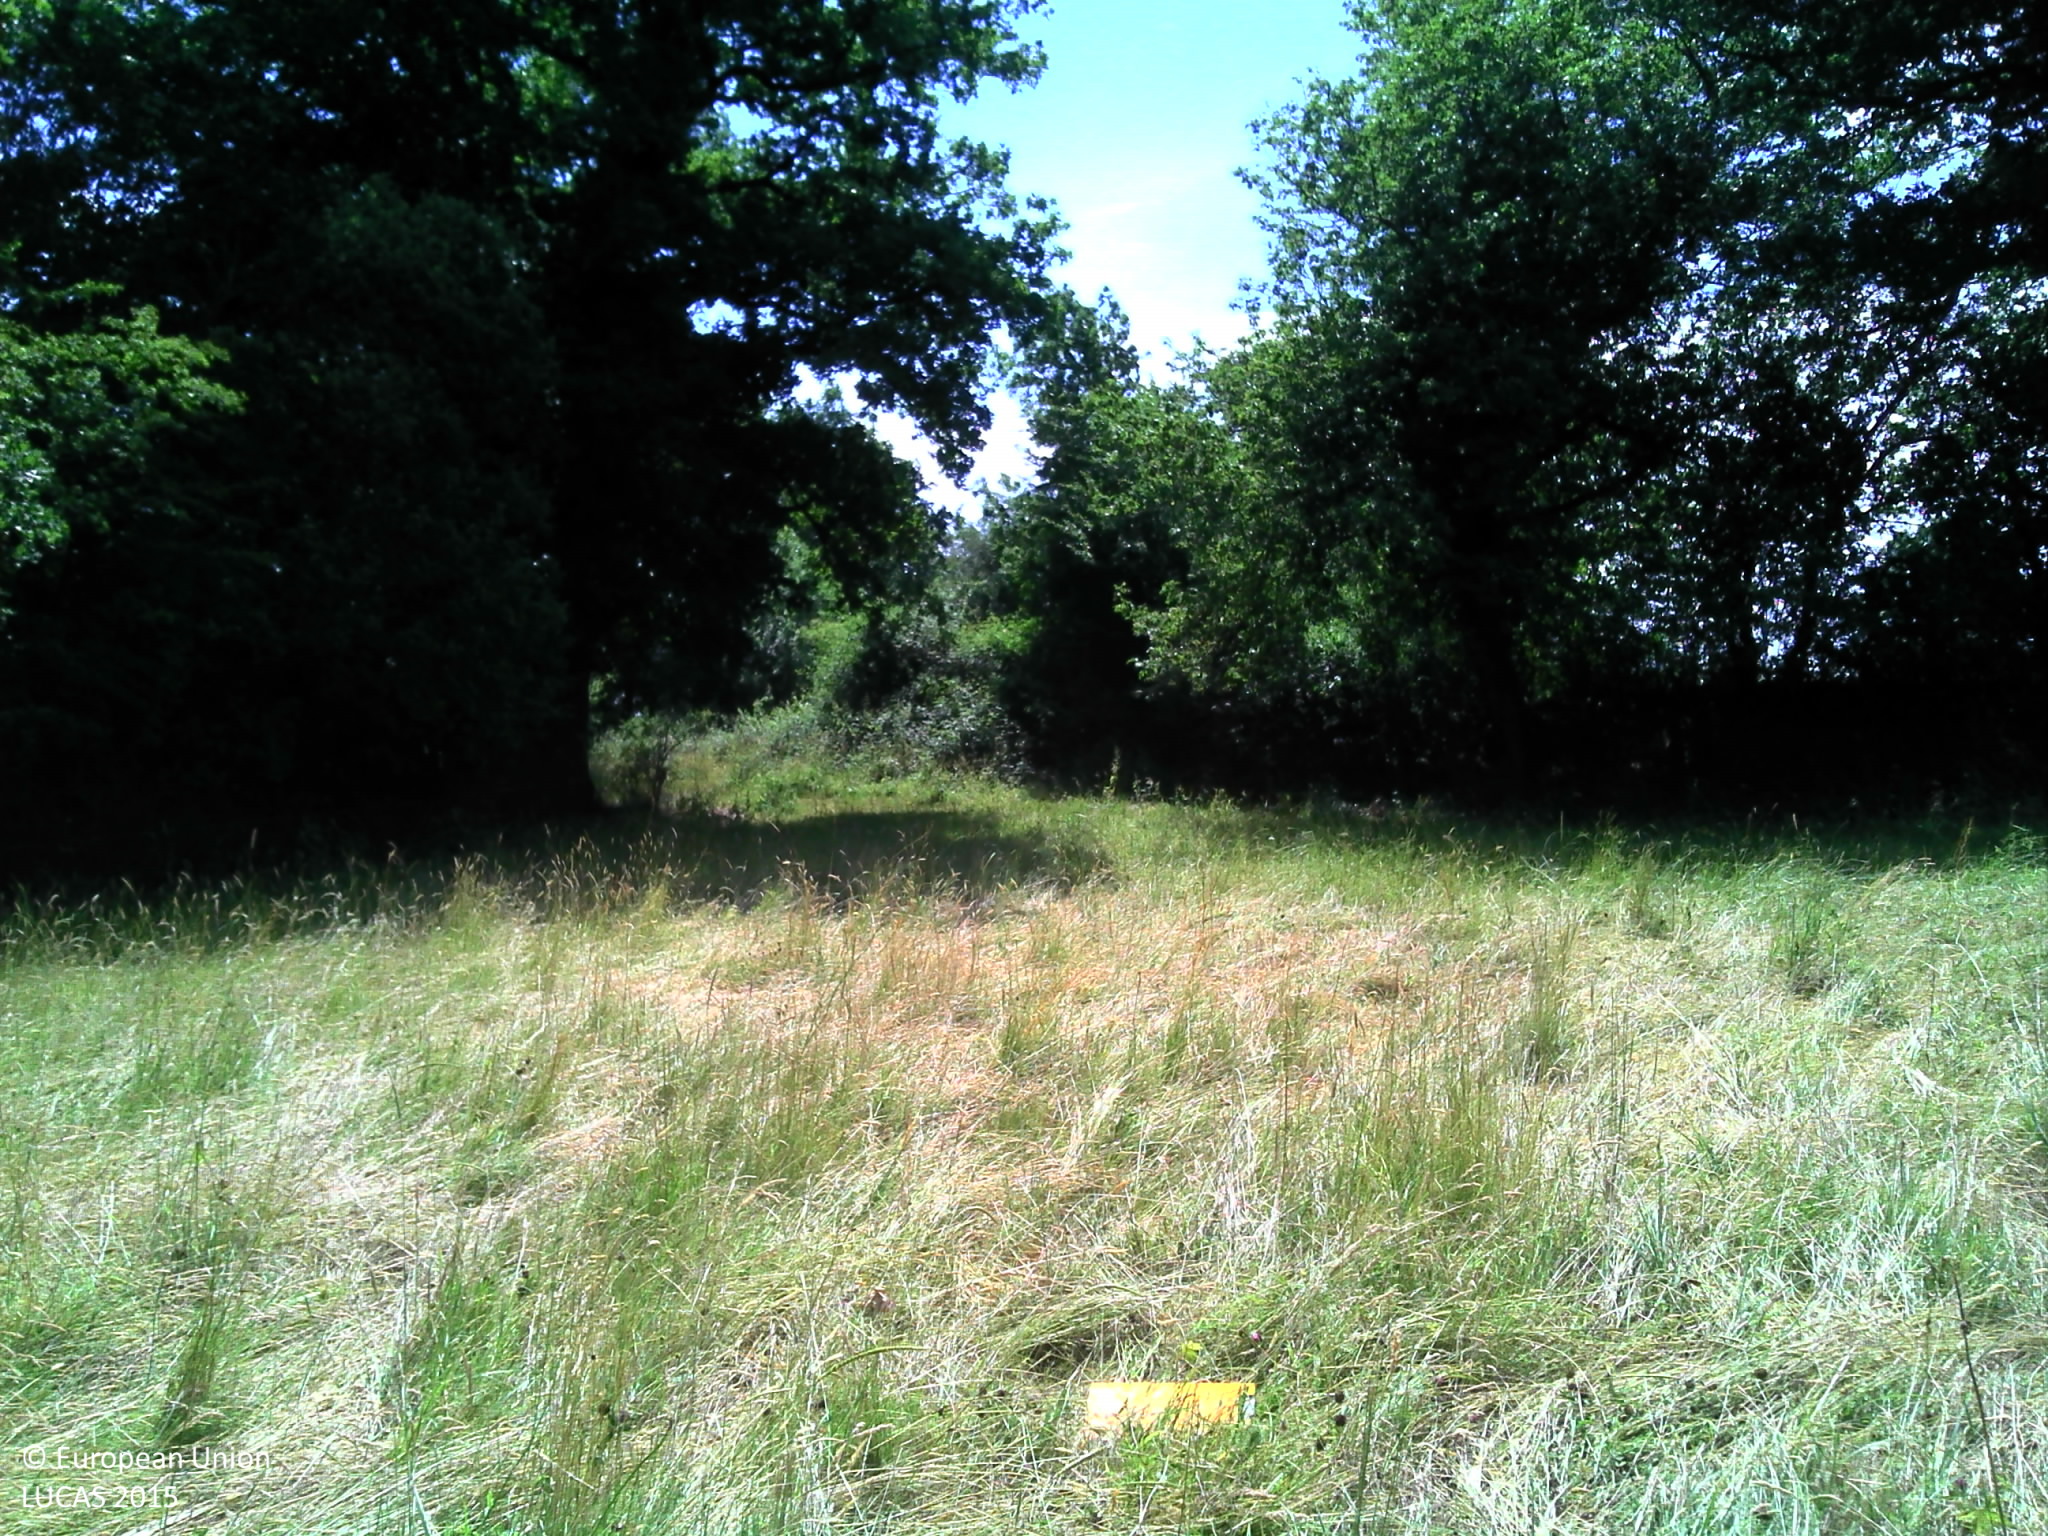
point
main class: Grassland
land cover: Grassland without tree/shrub cover
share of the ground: > 75 %
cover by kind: herbaceous plants 100 %
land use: Agriculture (excluding fallow land and kitchen gardens)
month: June
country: FR
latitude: 46.5164
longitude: 2.6836
